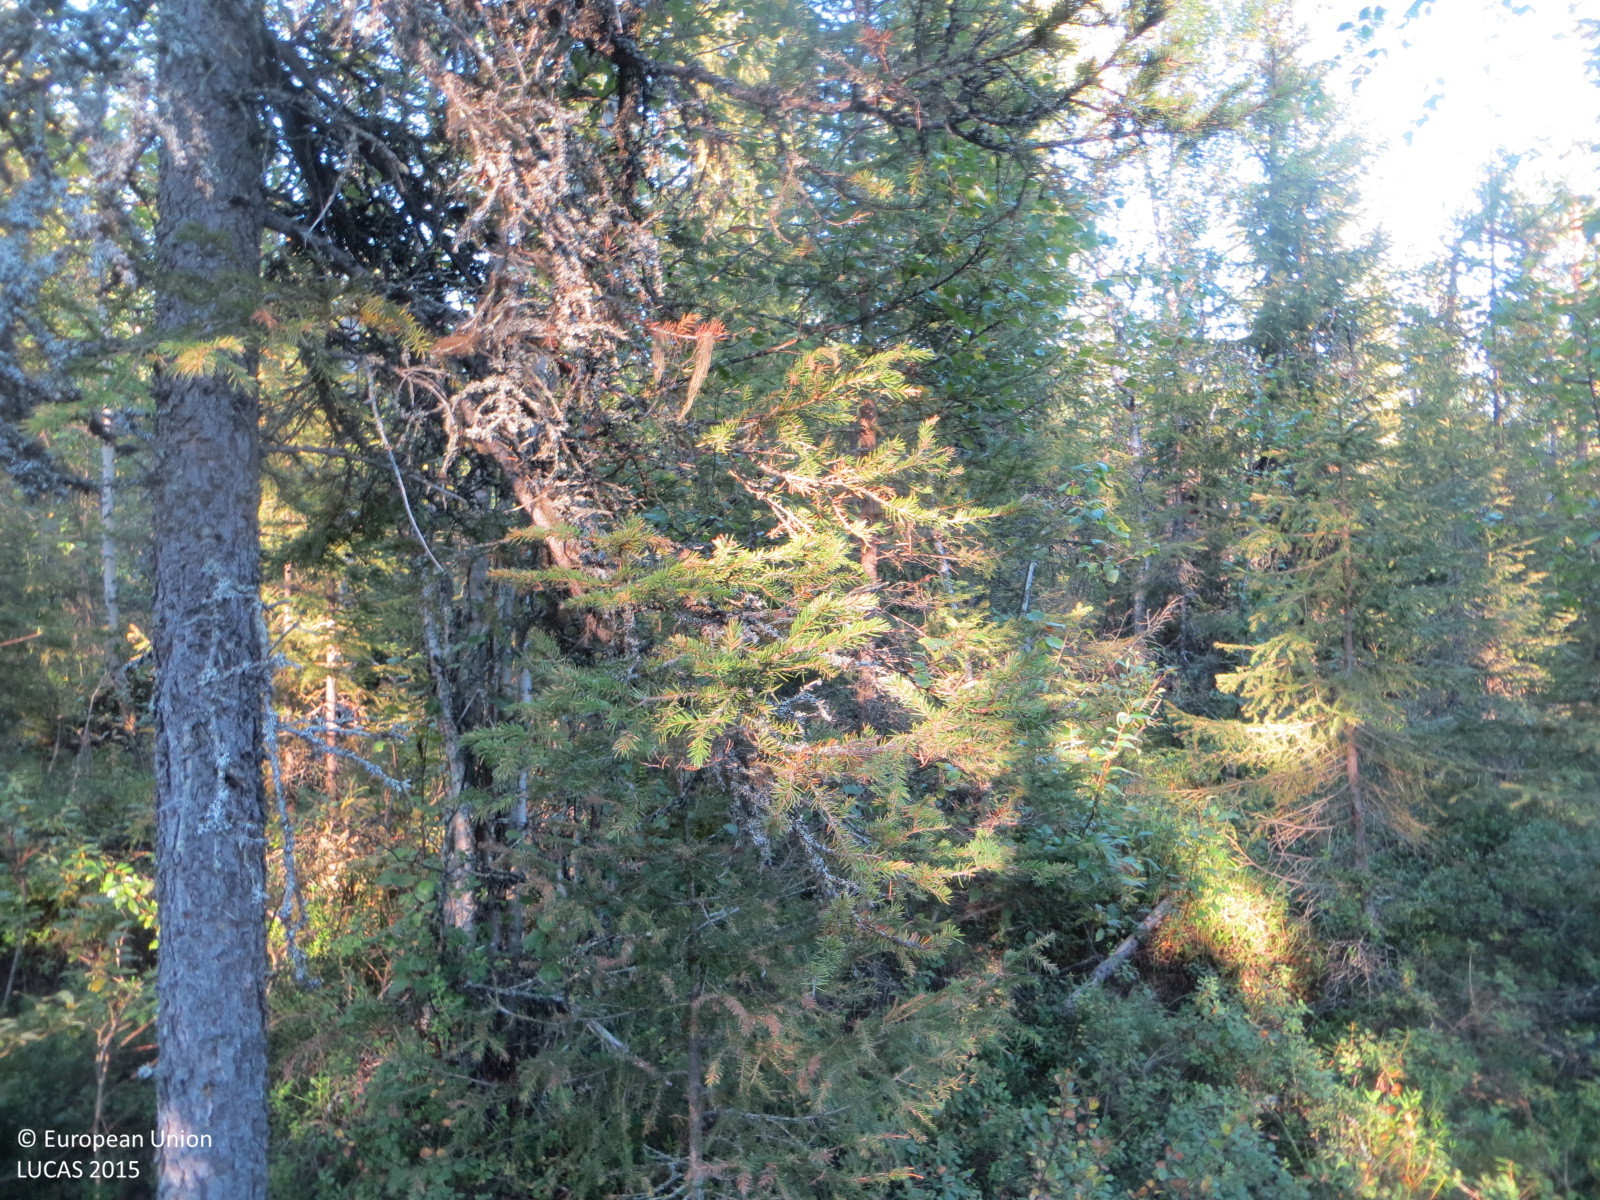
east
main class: Woodland
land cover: Spruce dominated mixed woodland
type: boreal forest
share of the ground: > 75 %
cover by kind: broadleaved forest trees 45 %, coniferous forest trees 30 %, shrubs 25 %
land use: Forestry
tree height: > 5 m
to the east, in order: Spruce dominated mixed woodland; Other mixed woodland; Ditches and canals; Other mixed woodland; Pine dominated coniferous woodland
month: August
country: FI
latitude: 67.0352
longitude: 24.0170
